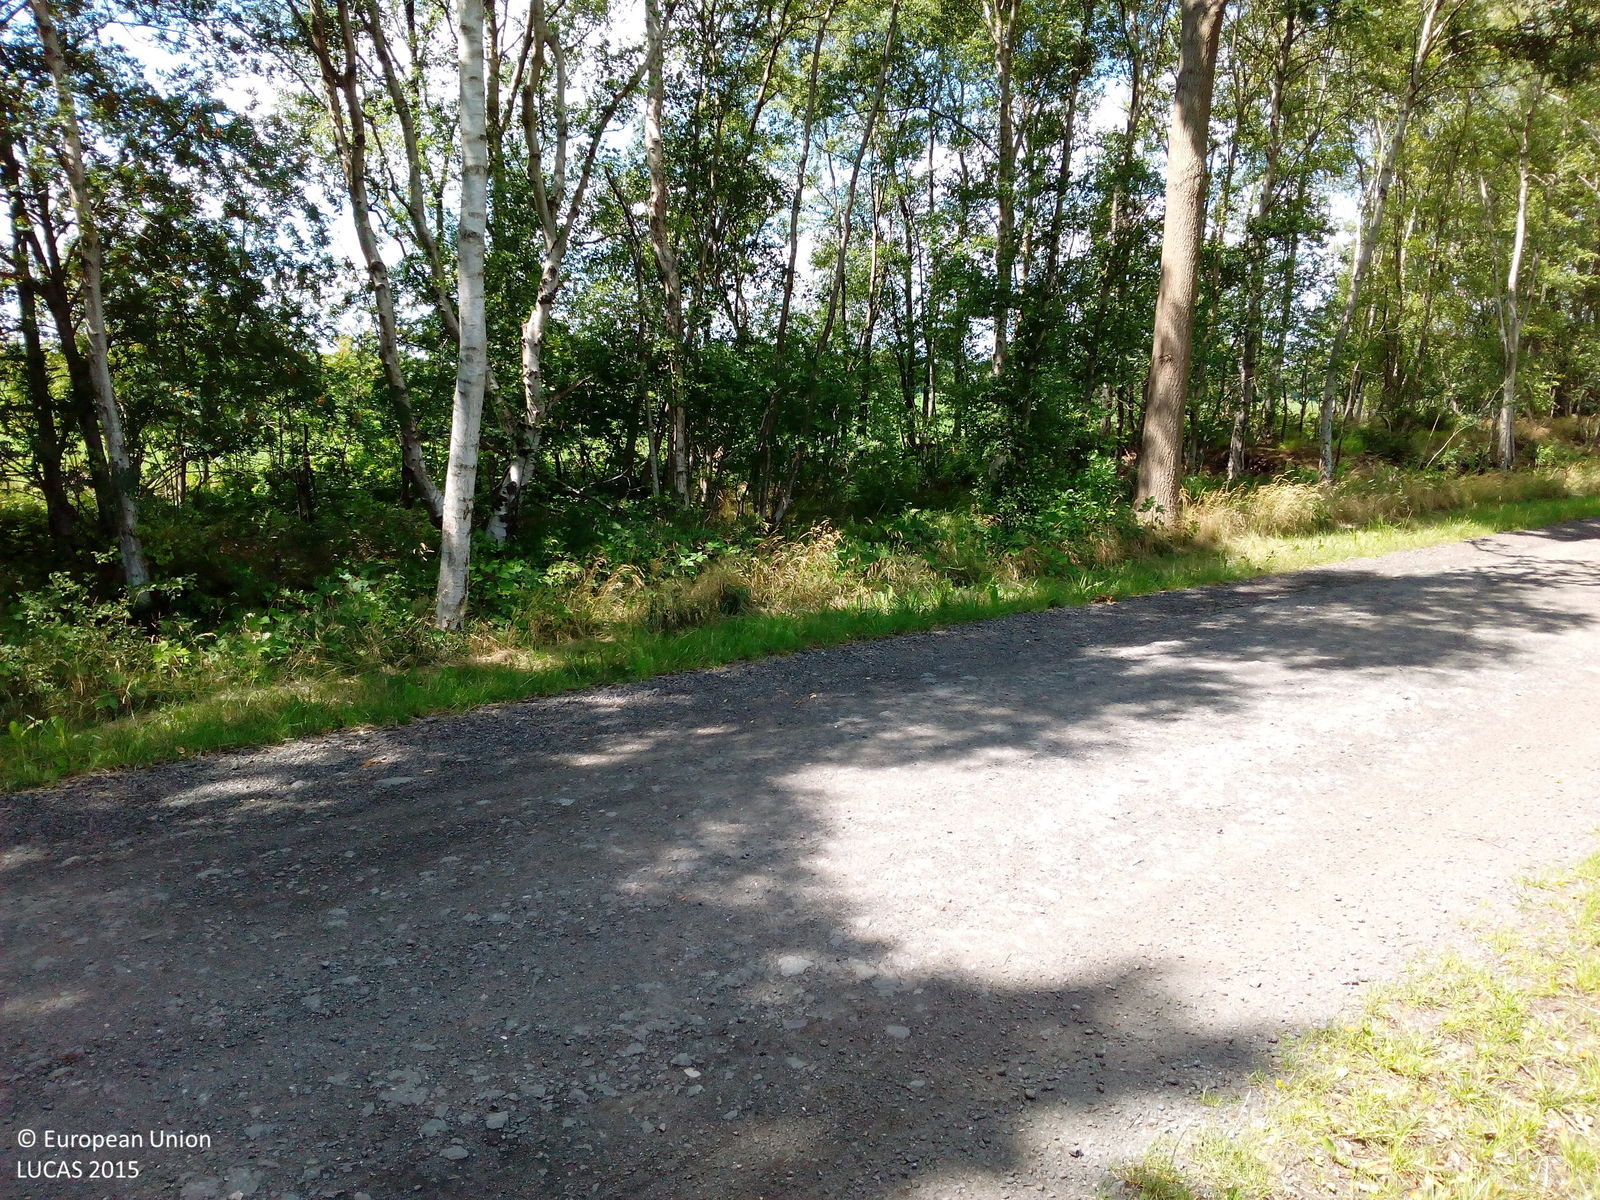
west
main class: Cropland
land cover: Maize
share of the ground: > 75 %
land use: Agriculture (excluding fallow land and kitchen gardens)
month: July
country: DE
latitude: 53.1499
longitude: 7.8923
